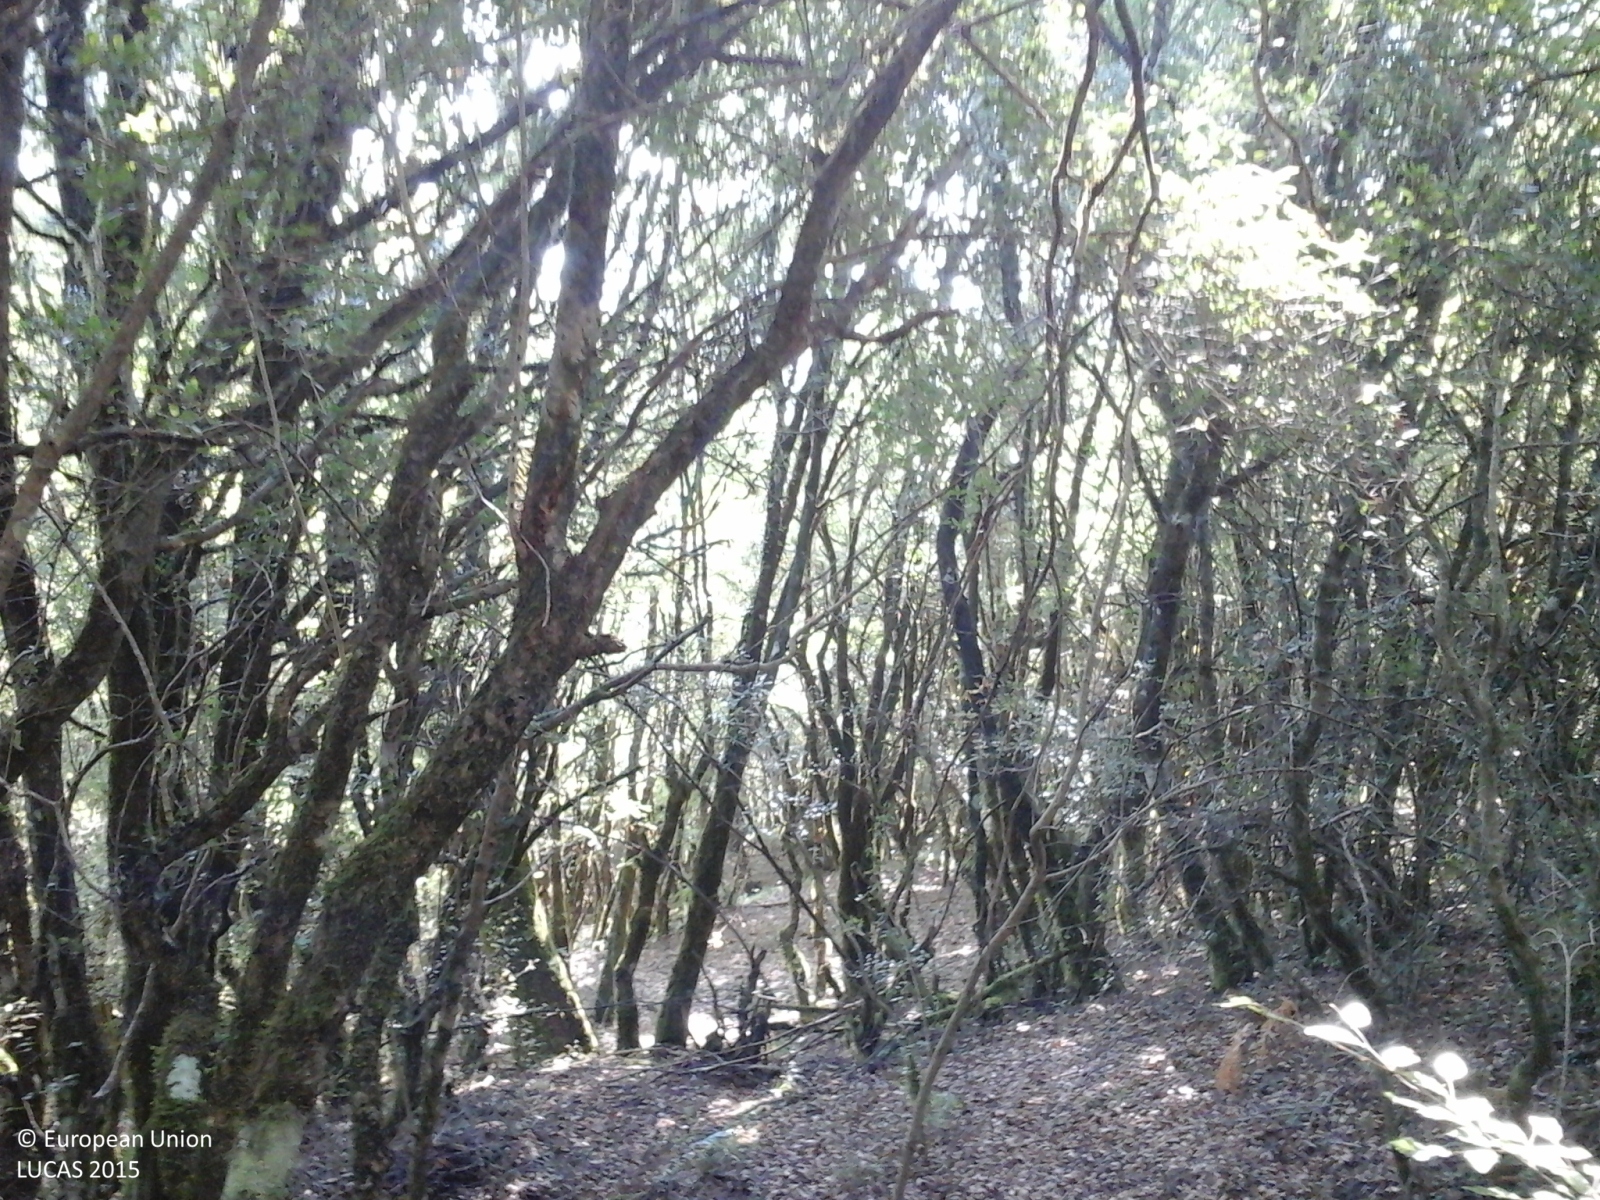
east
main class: Woodland
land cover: Broadleaved woodland
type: beech forest
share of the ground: > 75 %
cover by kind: broadleaved forest trees 90 %, unconsolidated bare surface 10 %
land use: Forestry
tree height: > 5 m
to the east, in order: Broadleaved woodland; Other mixed woodland; Dry stone walls; Other mixed woodland; Rivers and streams; Shrubland with sparse tree cover
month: September
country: GR
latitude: 39.5455
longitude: 20.6000
